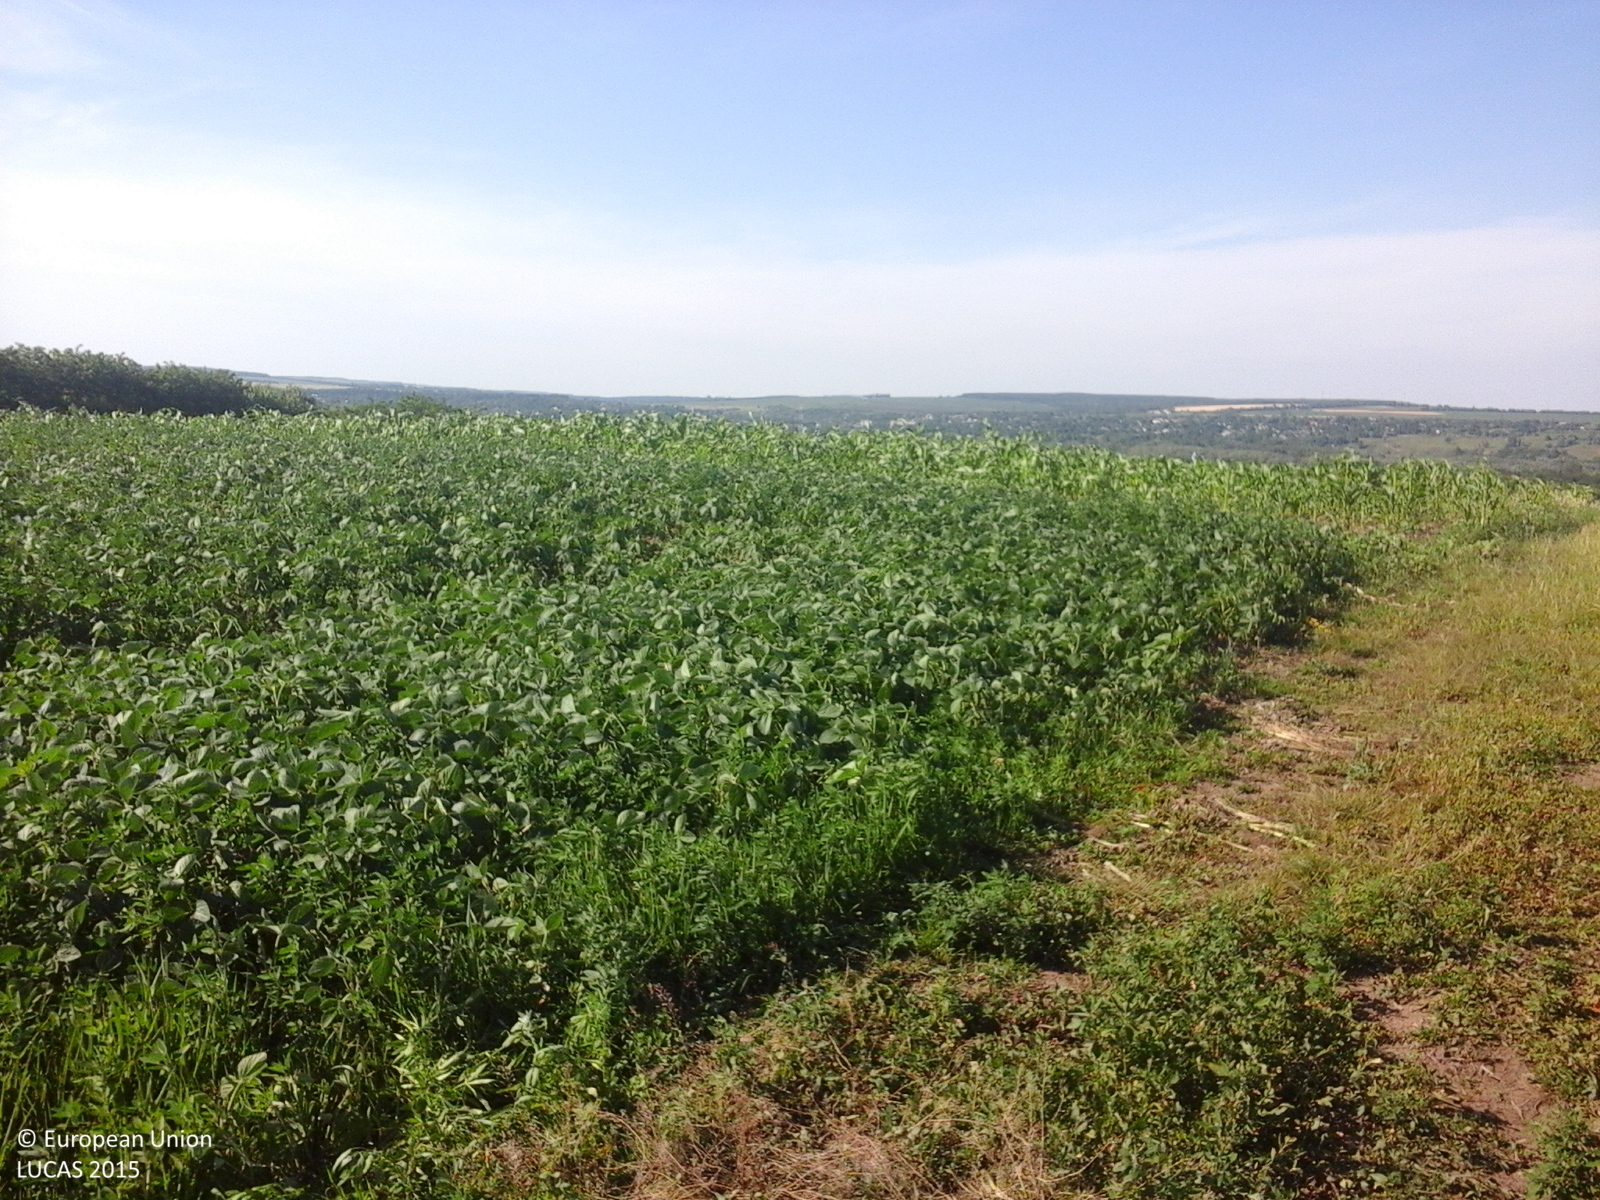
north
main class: Cropland
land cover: Common wheat
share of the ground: > 75 %
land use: Agriculture (excluding fallow land and kitchen gardens)
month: June
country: RO
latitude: 48.2255
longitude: 26.8075
